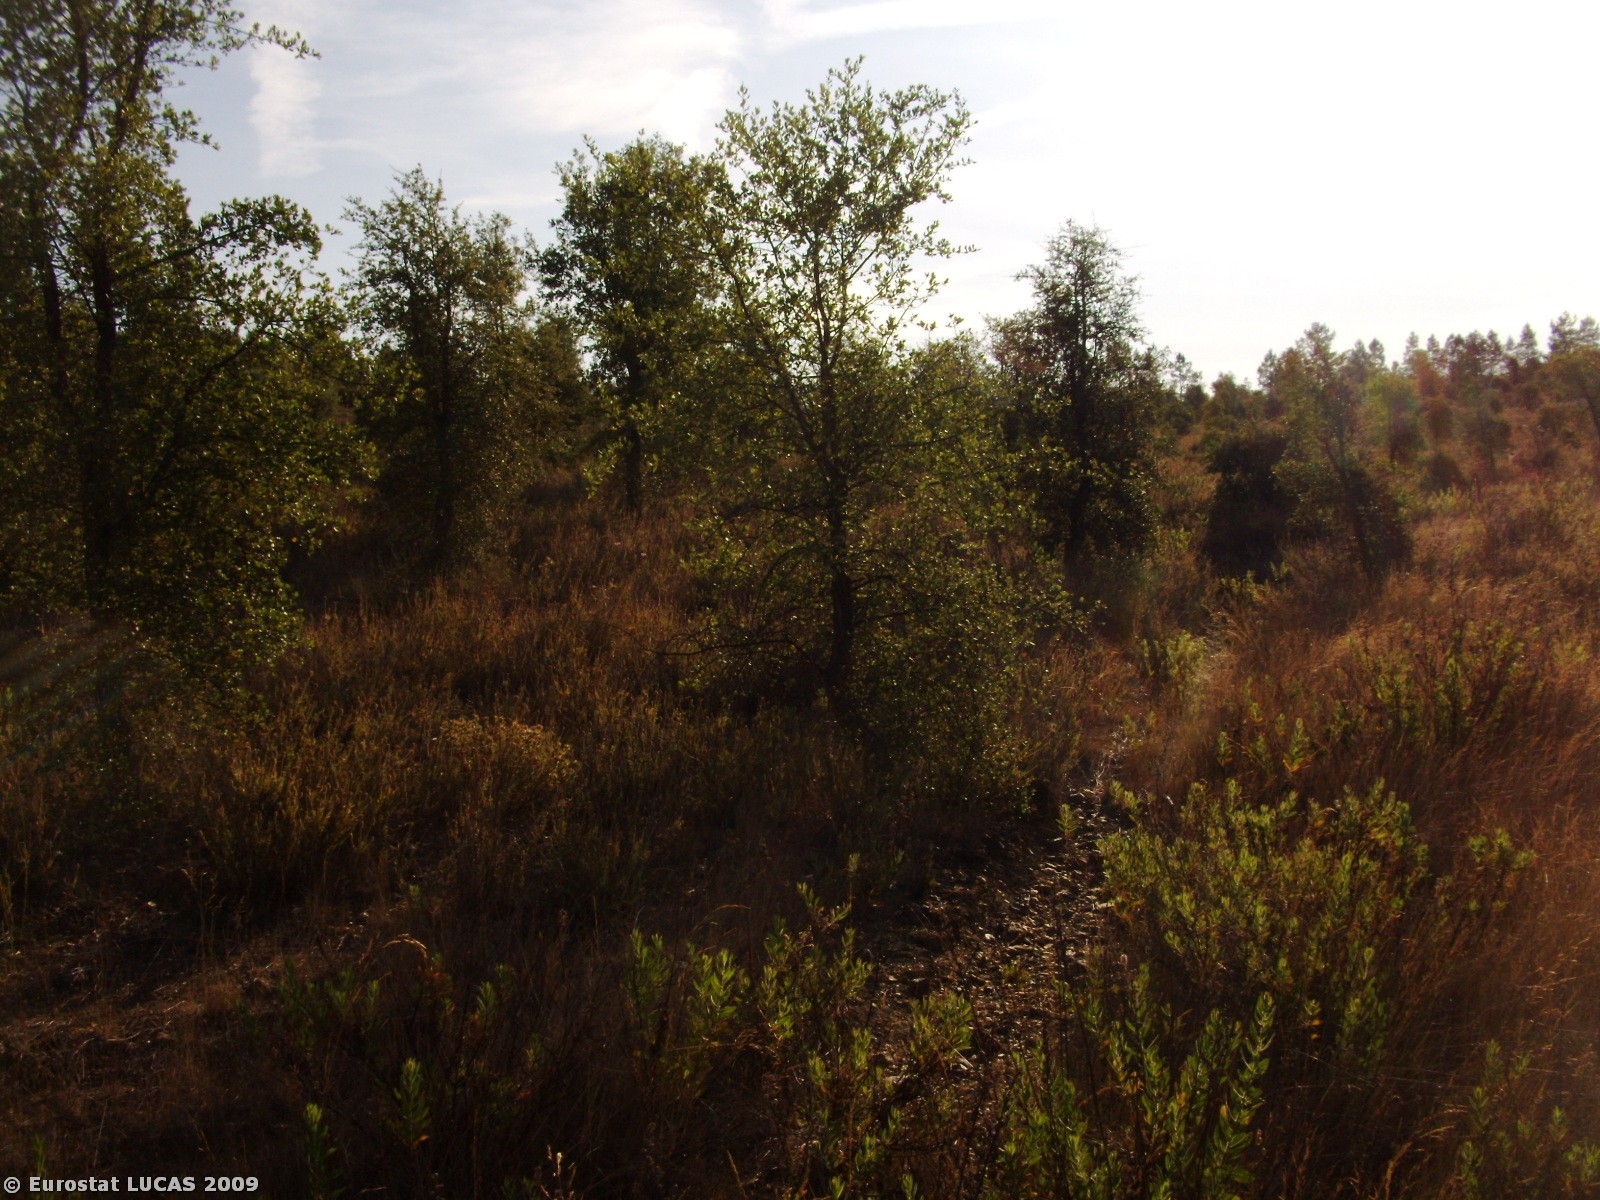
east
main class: Woodland
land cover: Broadleaved woodland
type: broadleaved evergreen forest
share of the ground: 25 - 50 %
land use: Forestry
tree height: > 5 m
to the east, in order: Broadleaved woodland; Tracks; Fences; Coniferous woodland; Broadleaved woodland
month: June
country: PT
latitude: 40.0903
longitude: -7.2572
